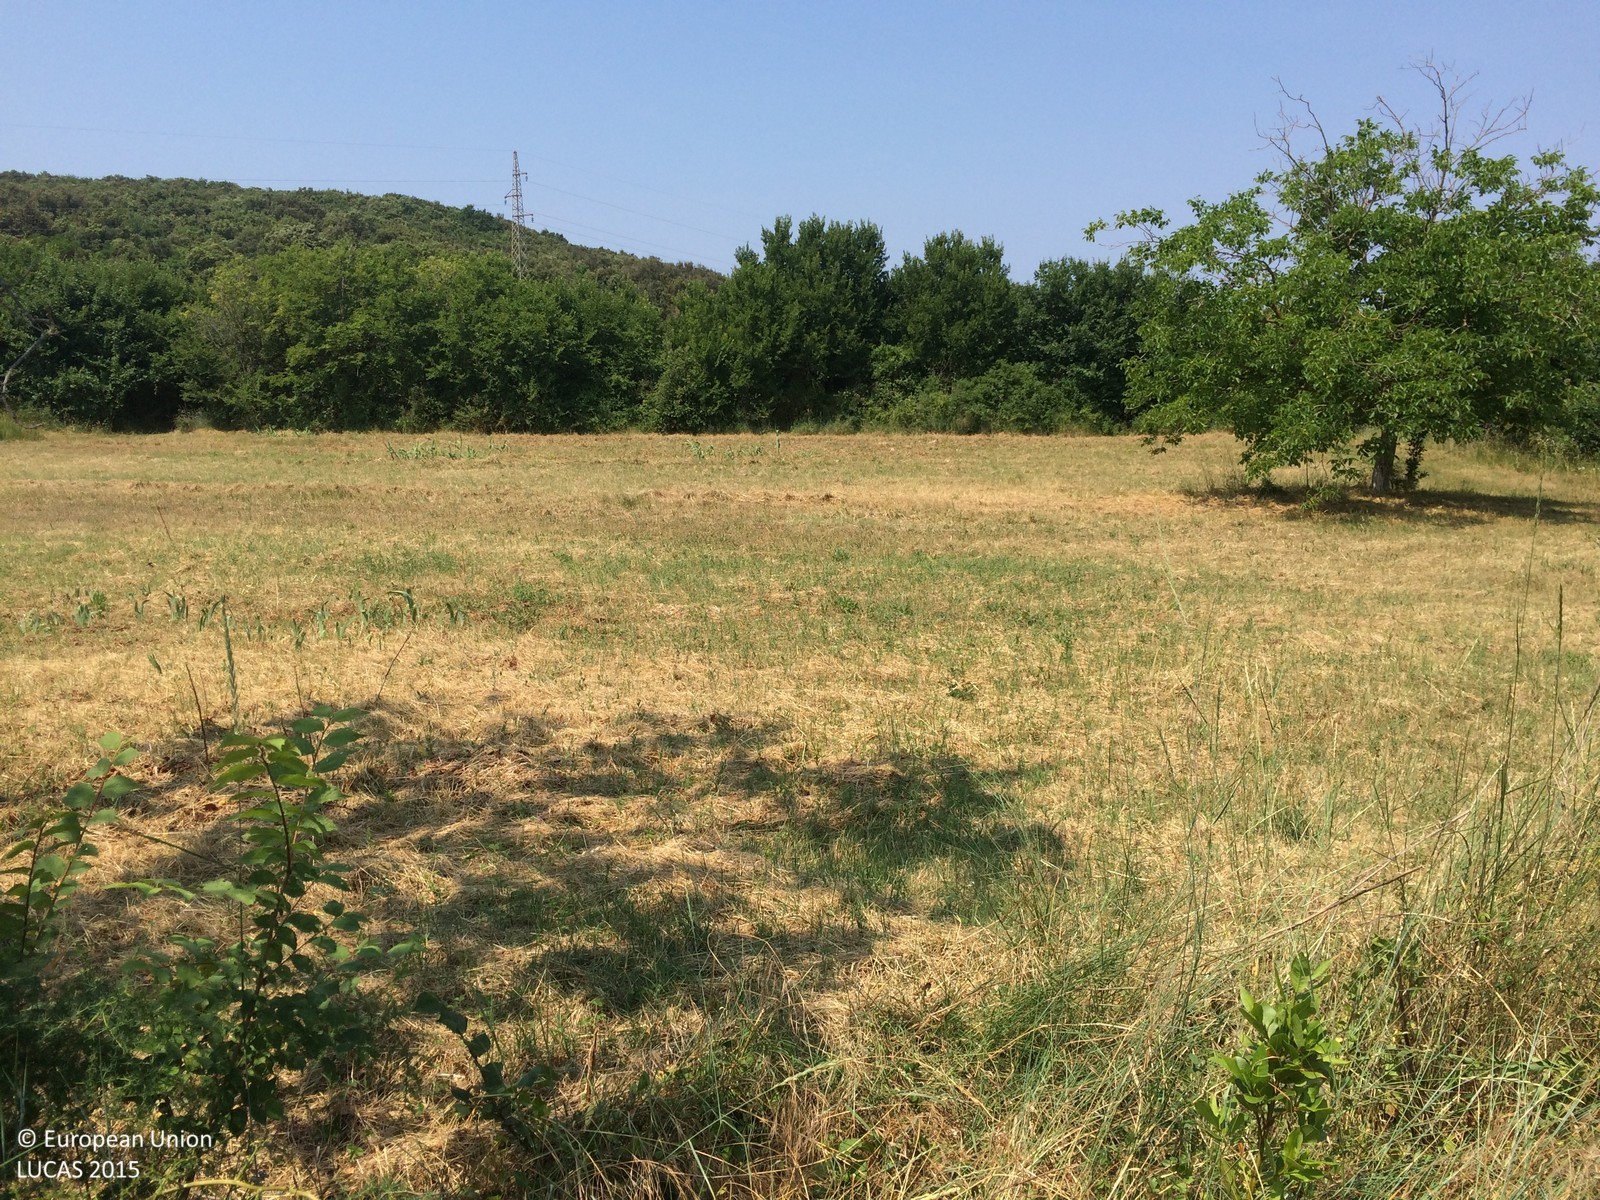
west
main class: Shrubland
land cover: Shrubland without tree cover
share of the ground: < 10 %
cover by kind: herbaceous plants 90 %, shrubs 10 %
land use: Semi-natural and natural areas not in use
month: June
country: HR
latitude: 45.1168
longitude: 13.6429
